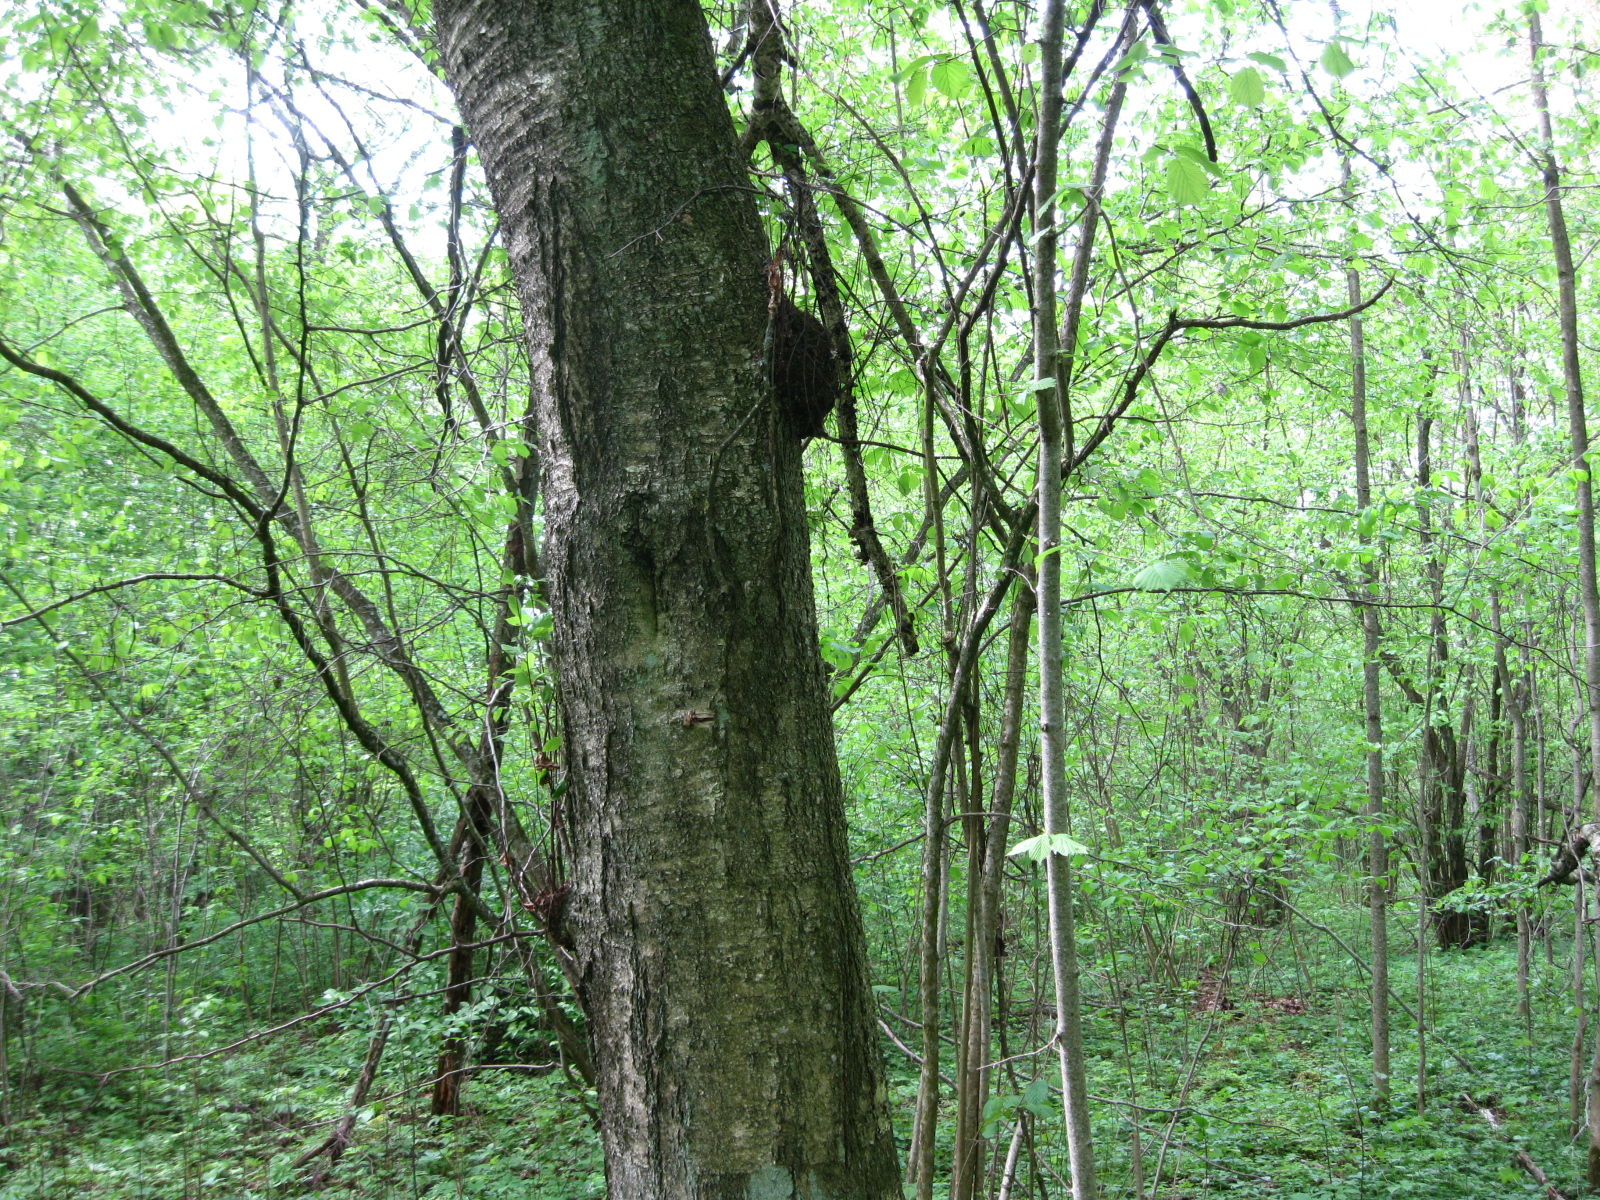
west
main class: Woodland
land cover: Broadleaved woodland
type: non-riverine alder, birch or aspen forest
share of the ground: > 75 %
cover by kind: broadleaved forest trees 85 %, shrubs 5 %, herbaceous plants 5 %, unconsolidated bare surface 5 %
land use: Forestry
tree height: > 5 m
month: May
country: LT
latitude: 56.2261
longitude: 24.2696
